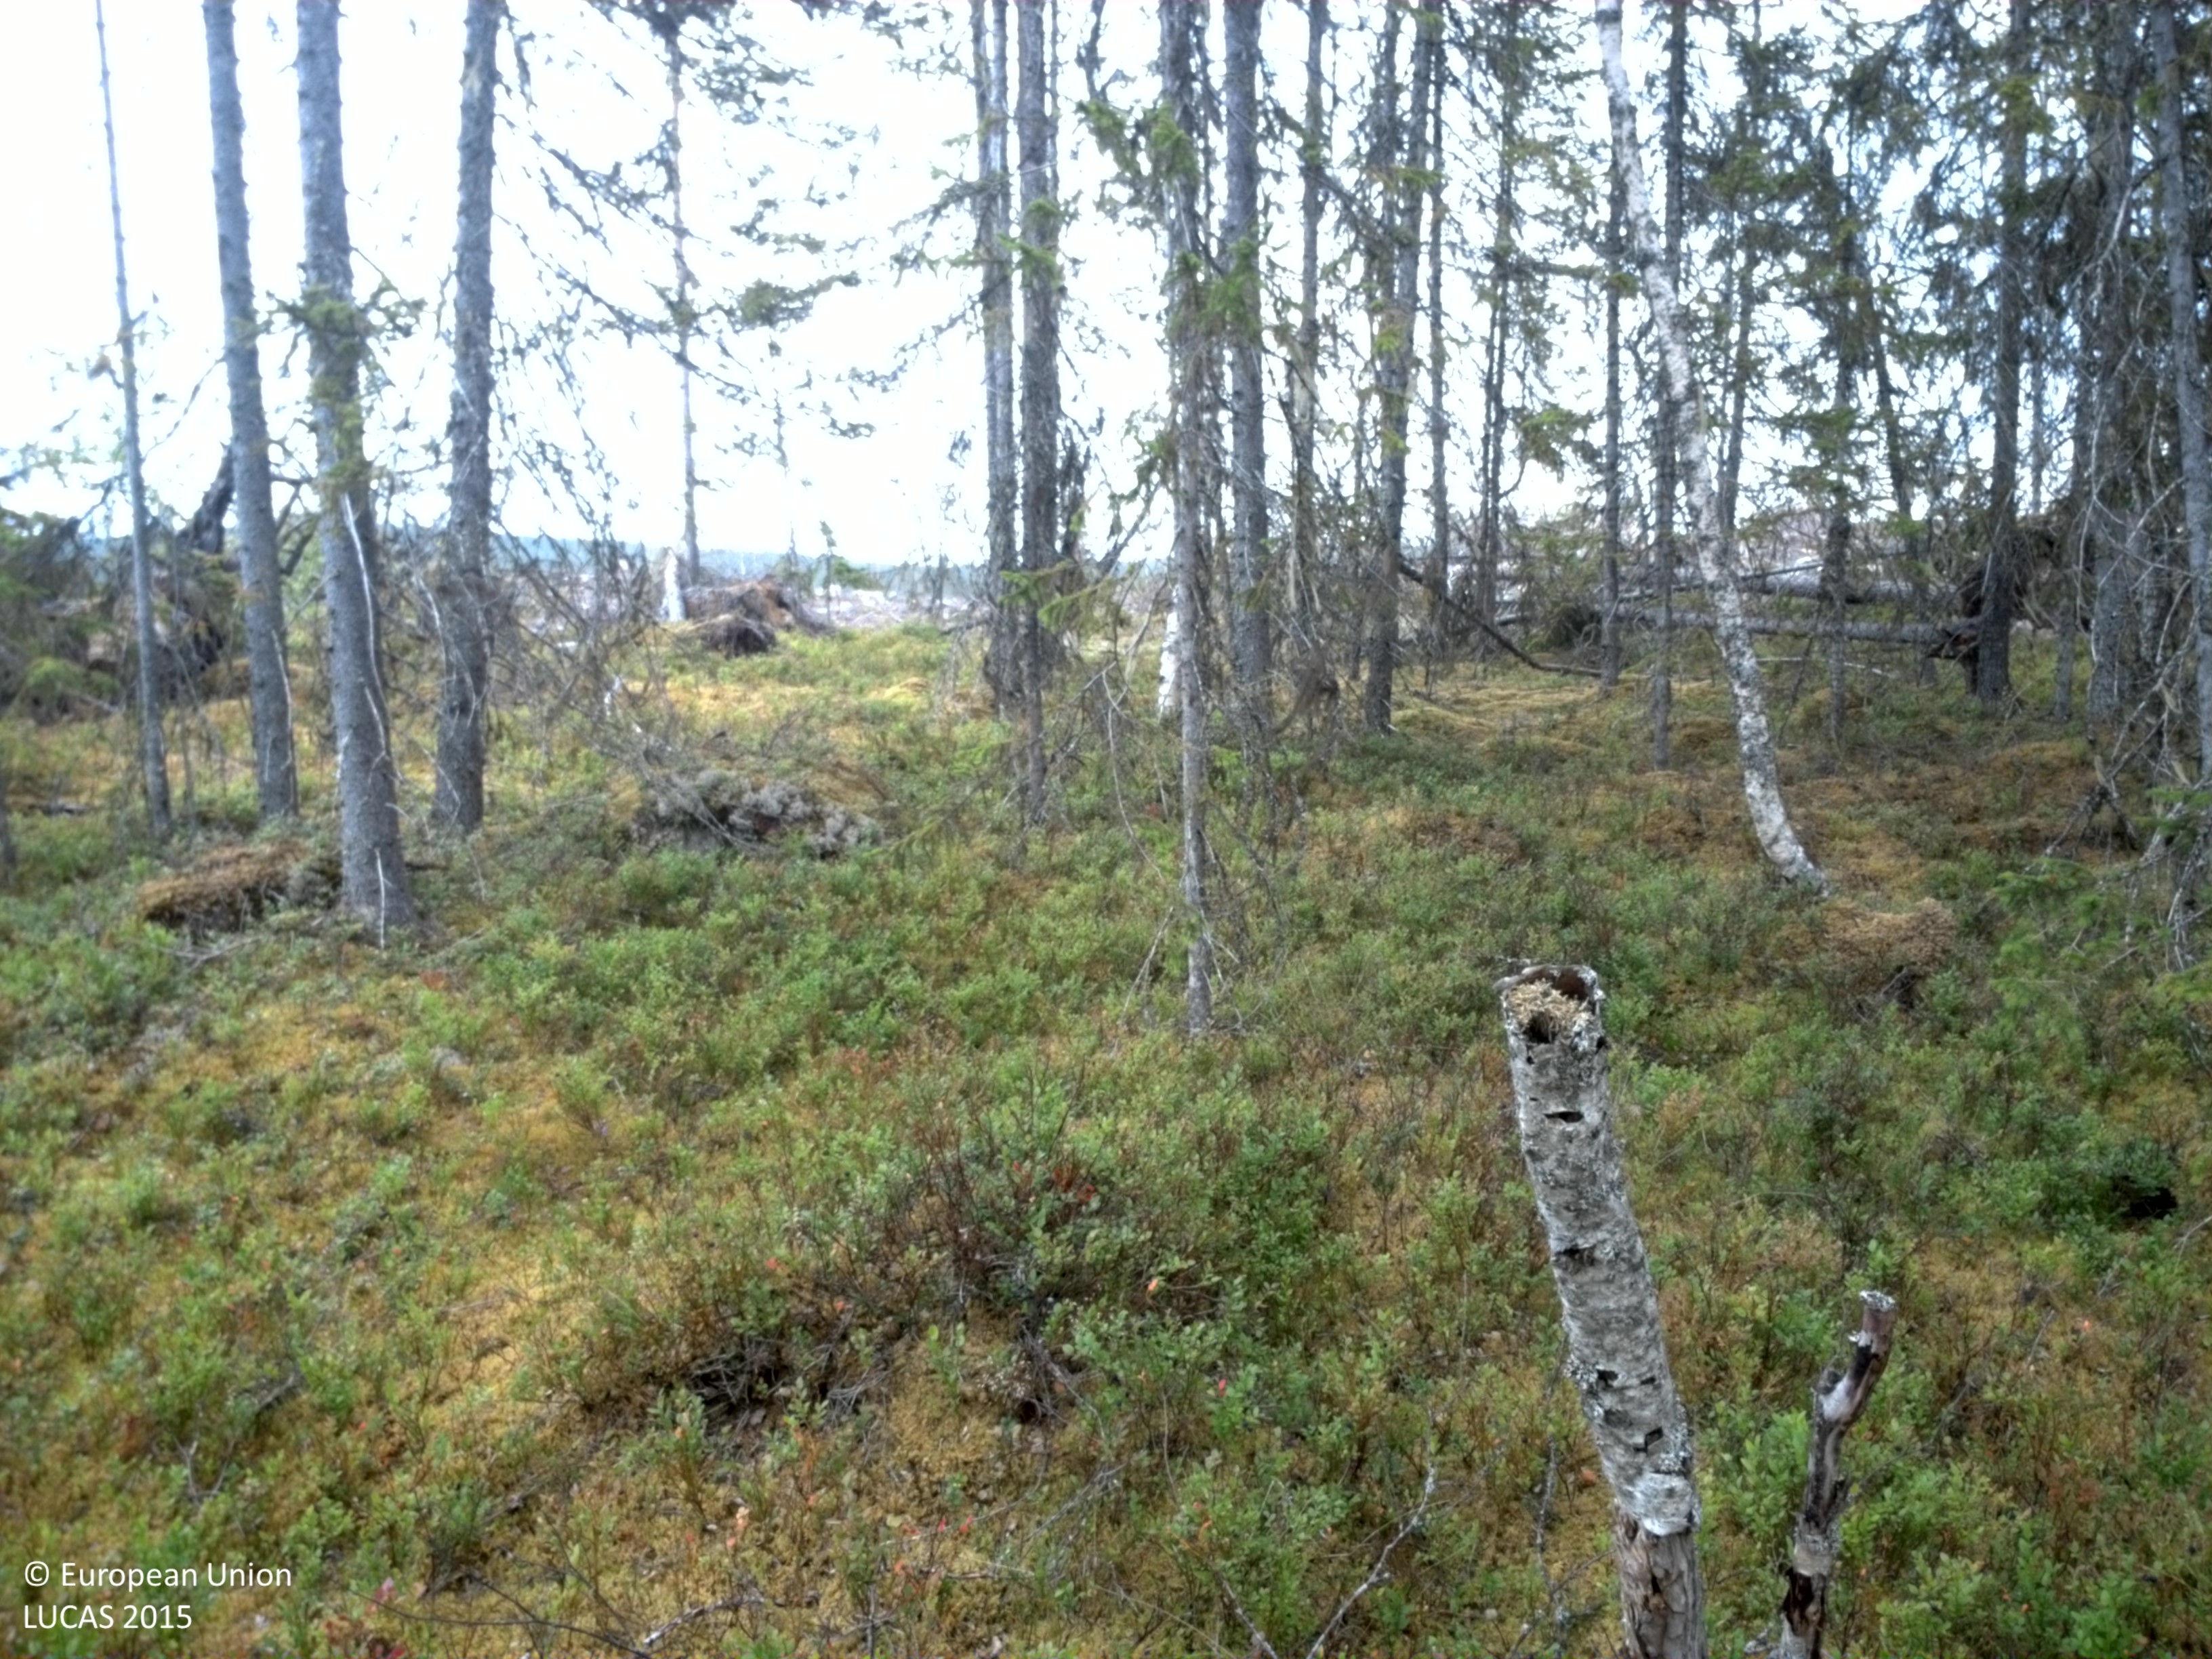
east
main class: Woodland
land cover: Spruce dominated mixed woodland
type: boreal forest
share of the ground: 25 - 50 %
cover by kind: coniferous forest trees 35 %, shrubs 30 %, lichens and mosses 20 %, broadleaved forest trees 15 %
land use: Forestry
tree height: > 5 m
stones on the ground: < 10 %
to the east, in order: Spruce dominated mixed woodland; Shrubland with sparse tree cover; Pine dominated mixed woodland
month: August
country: SE
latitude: 61.8783
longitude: 15.0227
